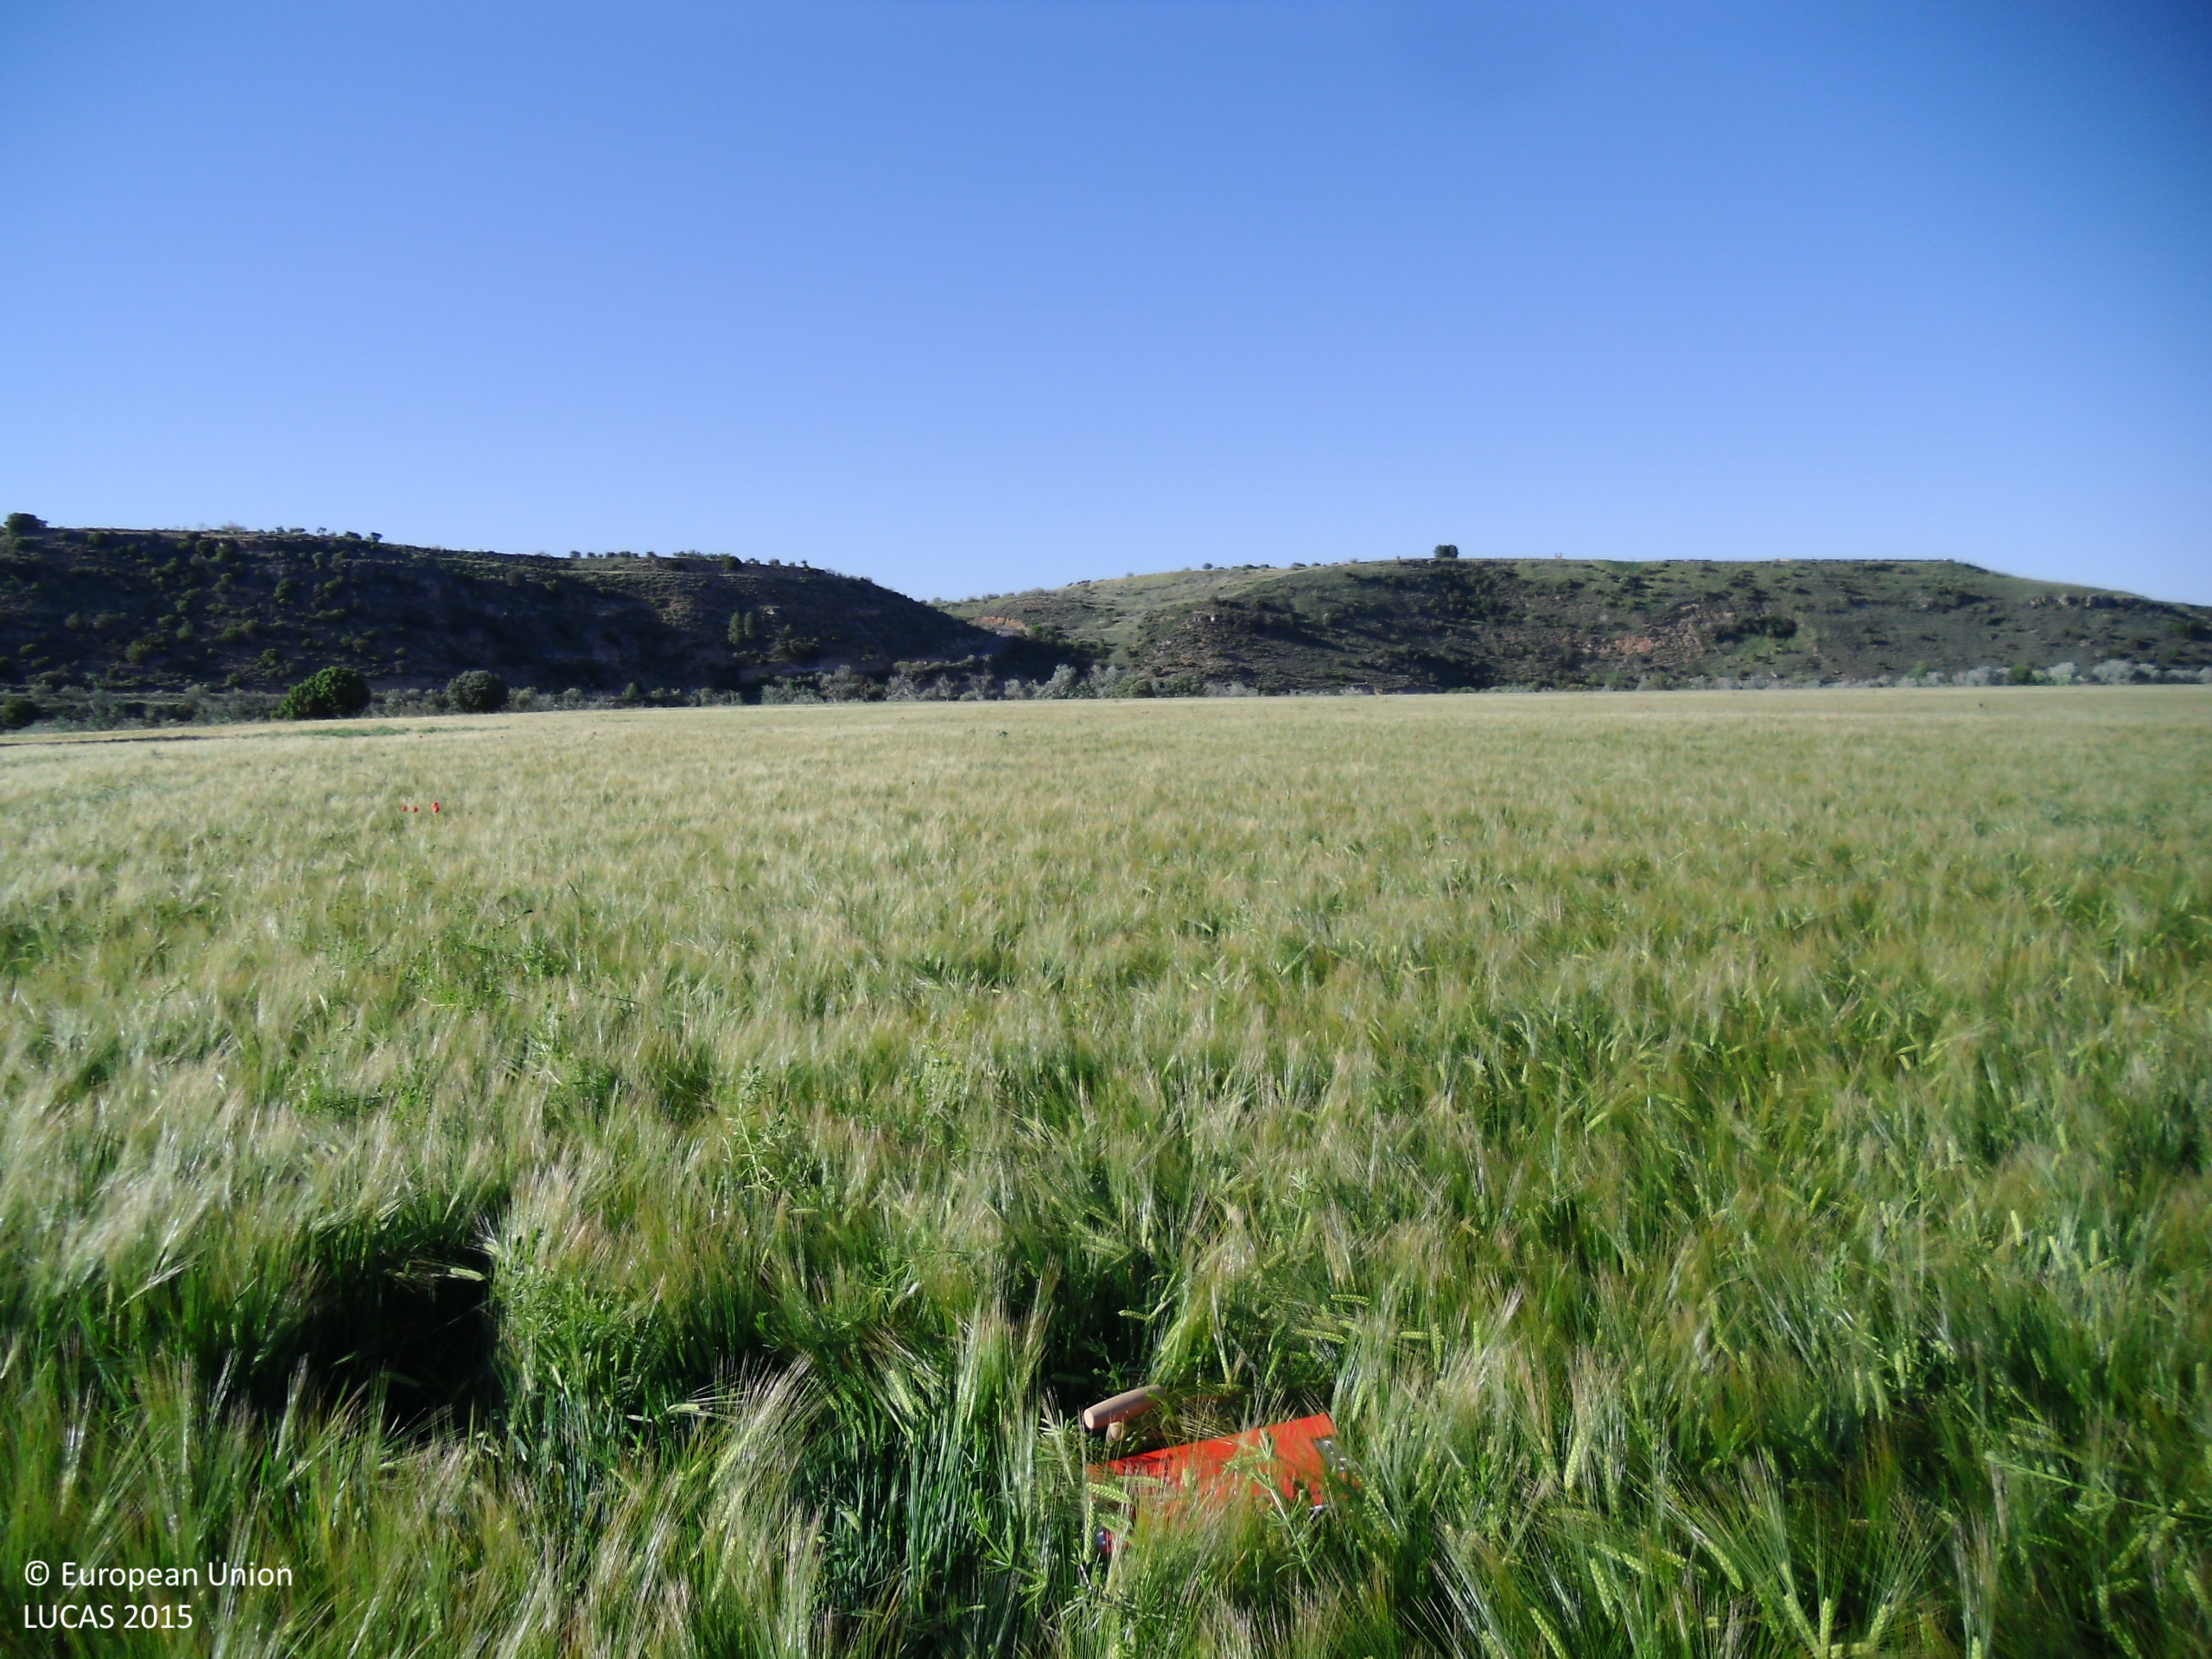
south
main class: Cropland
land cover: Barley
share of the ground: > 75 %
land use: Agriculture (excluding fallow land and kitchen gardens)
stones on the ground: > 50 %
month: May
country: ES
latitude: 40.3278
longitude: -2.8908
